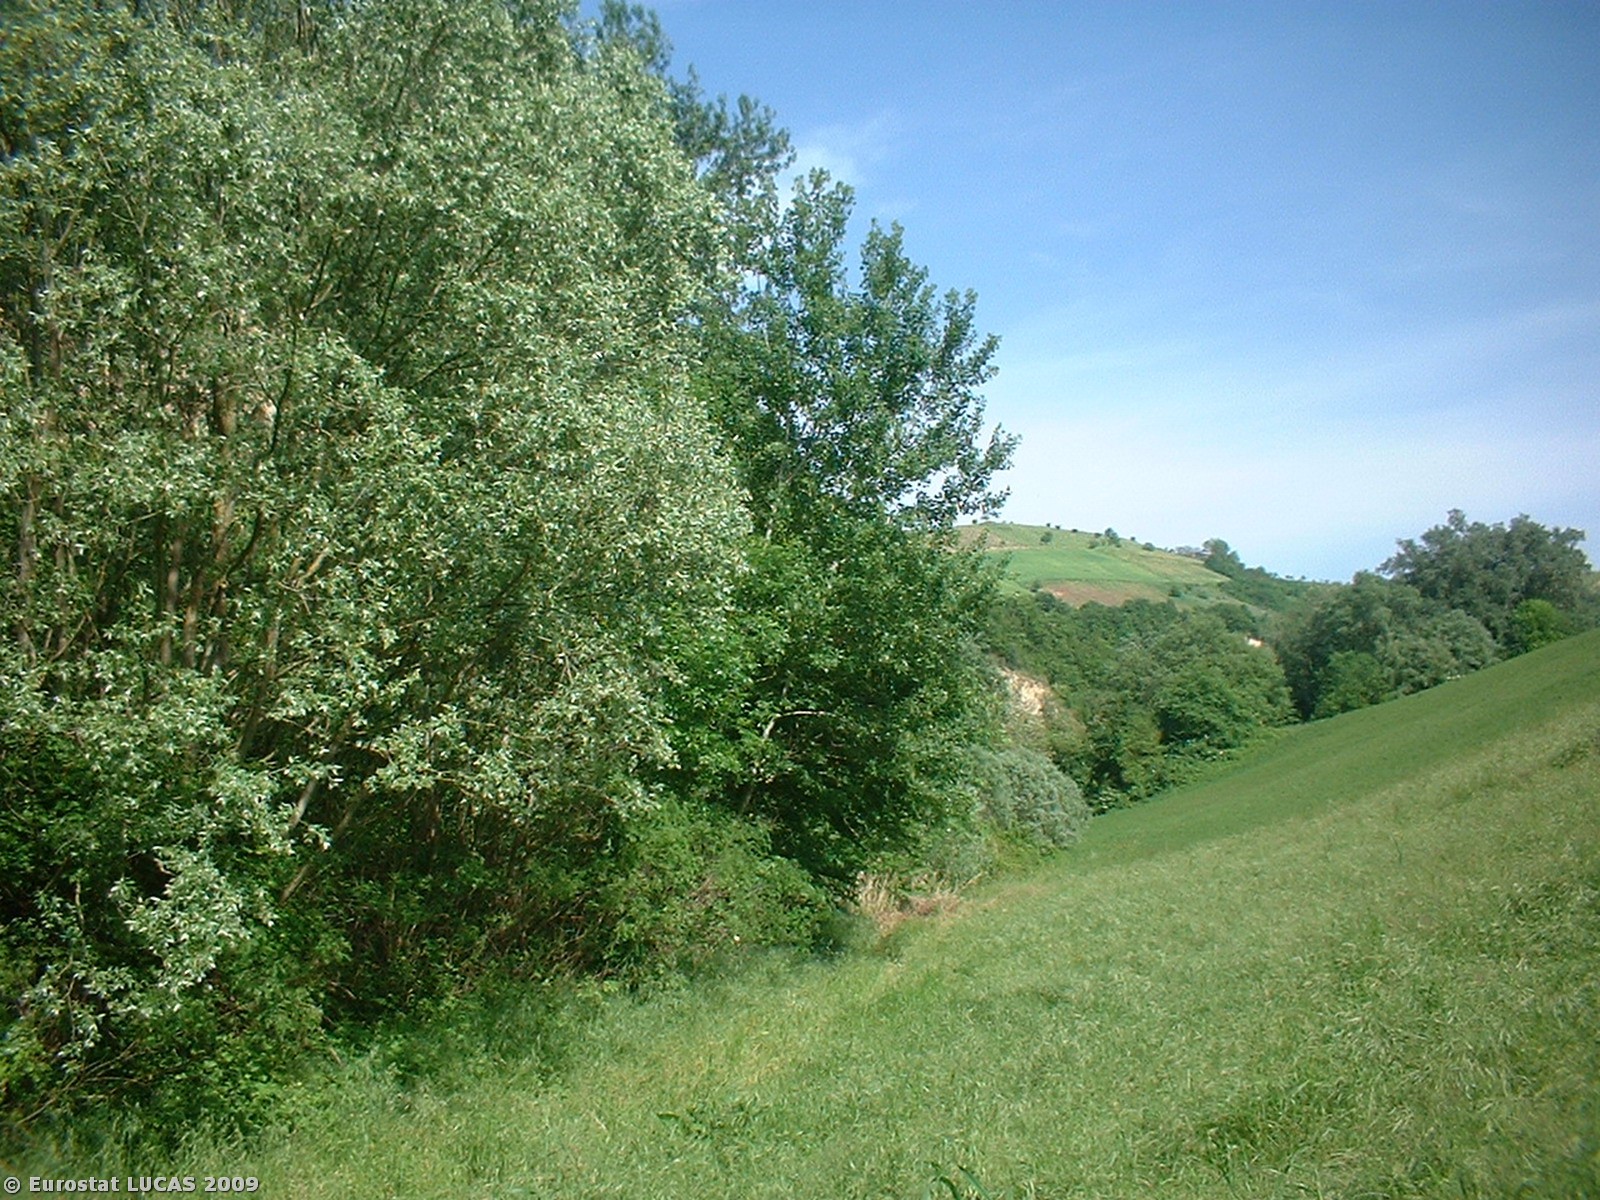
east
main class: Cropland
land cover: Temporary grasslands
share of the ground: > 75 %
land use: Agriculture (excluding fallow land and kitchen gardens)
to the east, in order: Temporary grasslands; Broadleaved woodland; Bare land; Shrubland with sparse tree cover
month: May
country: IT
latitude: 43.0010
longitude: 13.7314
